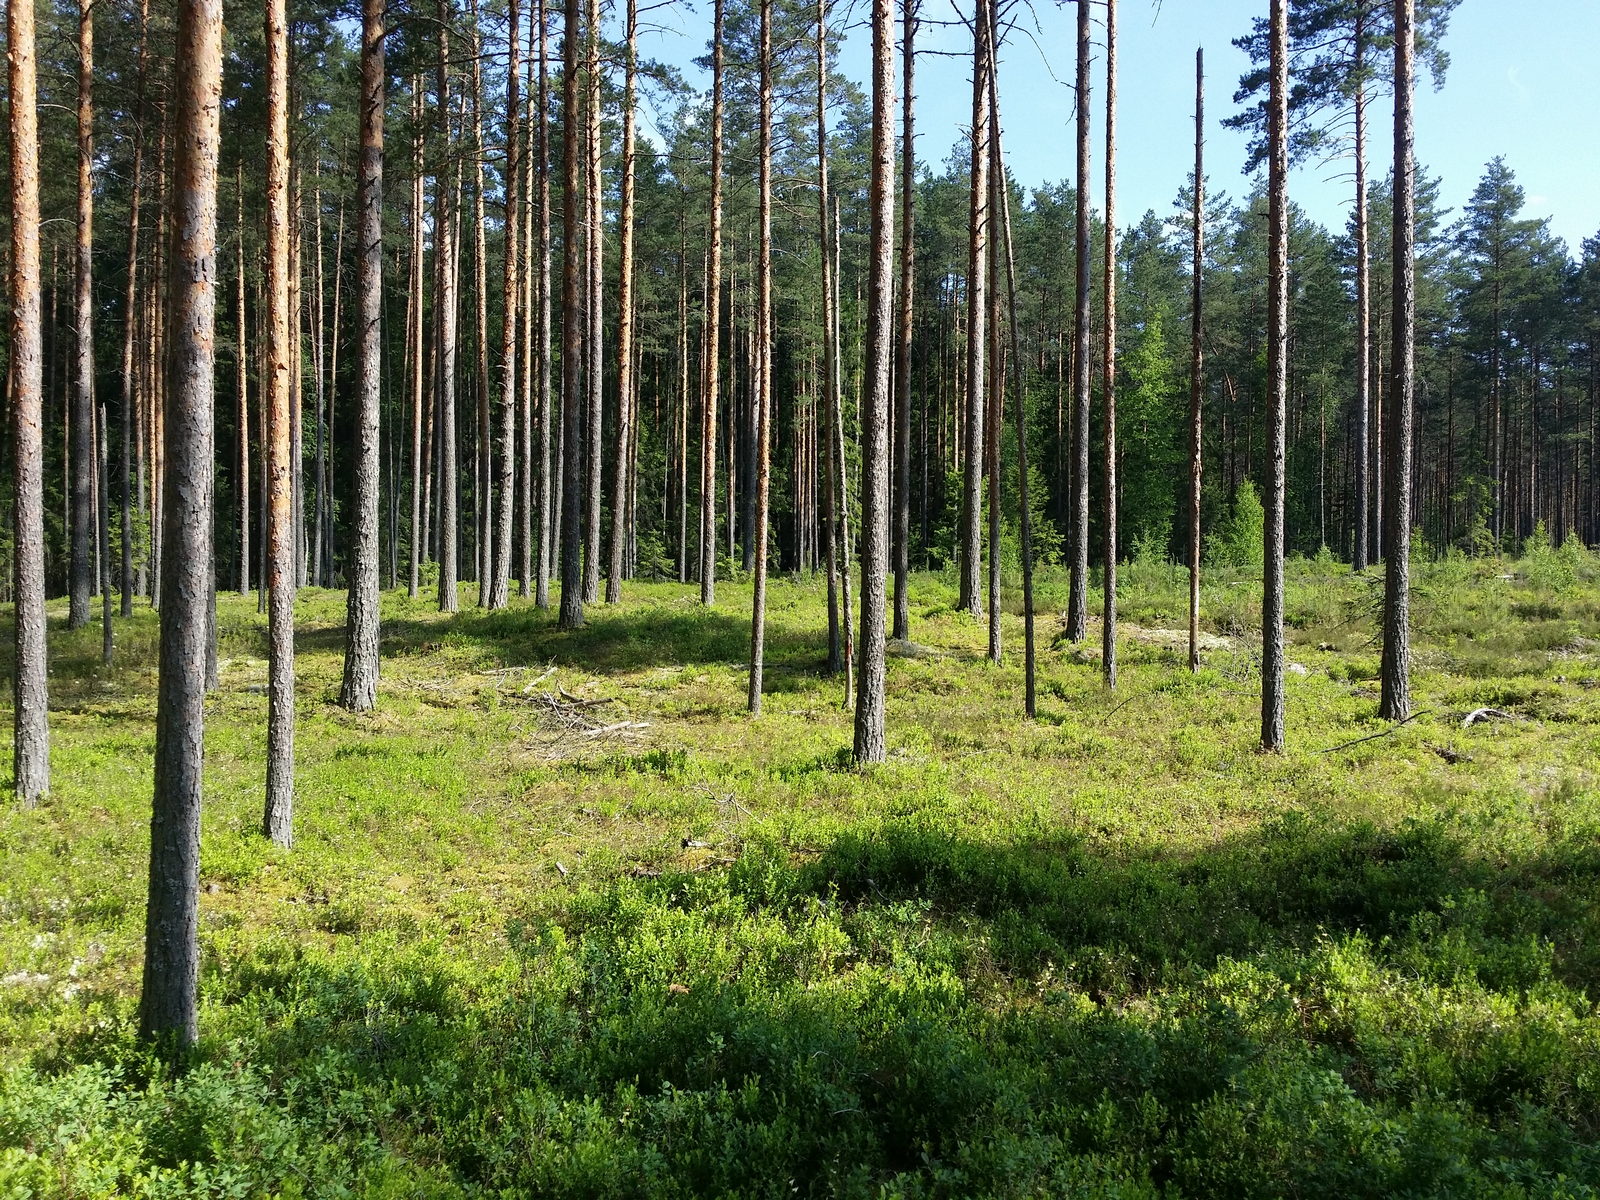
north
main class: Woodland
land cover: Pine dominated coniferous woodland
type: hemiboreal forest and nemoral coniferous forest and mixed broadleaved-coniferous forest
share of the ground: 50 - 75 %
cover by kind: coniferous forest trees 60 %, shrubs 20 %, herbaceous plants 10 %, lichens and mosses 10 %
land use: Forestry
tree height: > 5 m
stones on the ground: < 10 %
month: June
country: LV
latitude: 57.3483
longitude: 26.5471
